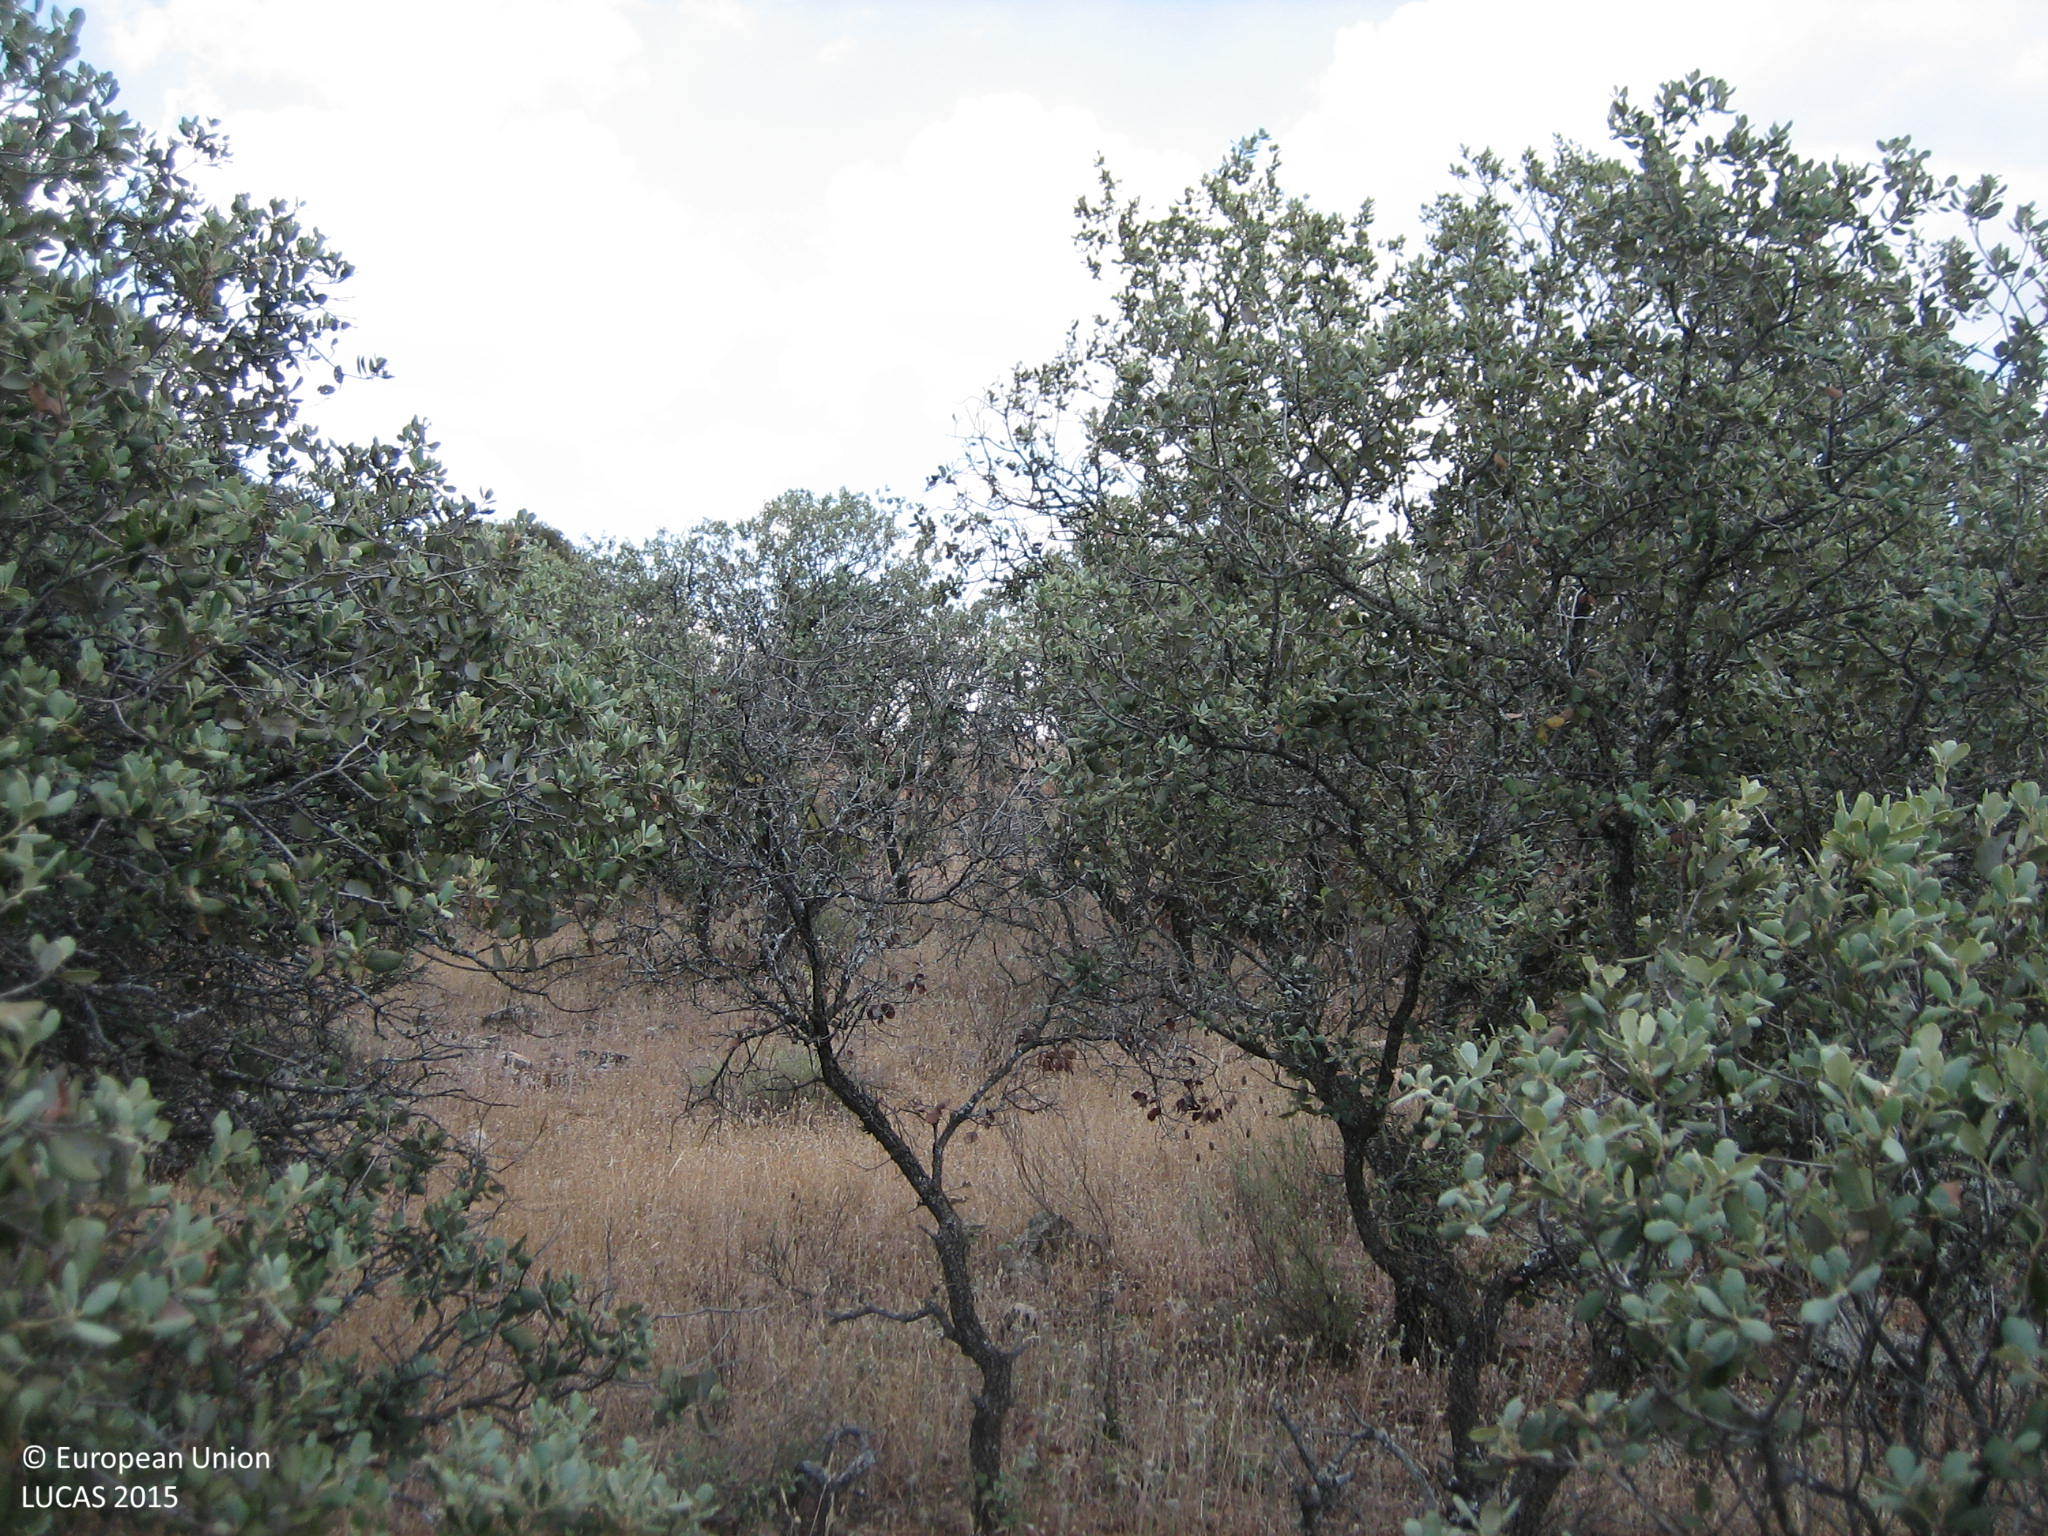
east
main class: Woodland
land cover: Broadleaved woodland
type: broadleaved evergreen forest
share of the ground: 50 - 75 %
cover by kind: broadleaved forest trees 70 %, herbaceous plants 30 %
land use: Semi-natural and natural areas not in use
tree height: < 5 m
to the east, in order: Broadleaved woodland; Fences; Grassland without tree/shrub cover; Paved roads, cycling and walking lanes; Grassland without tree/shrub cover; Fences; Grassland with sparse tree/shrub cover; Tracks; Grassland with sparse tree/shrub cover
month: May
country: ES
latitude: 38.8305
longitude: -4.0385
